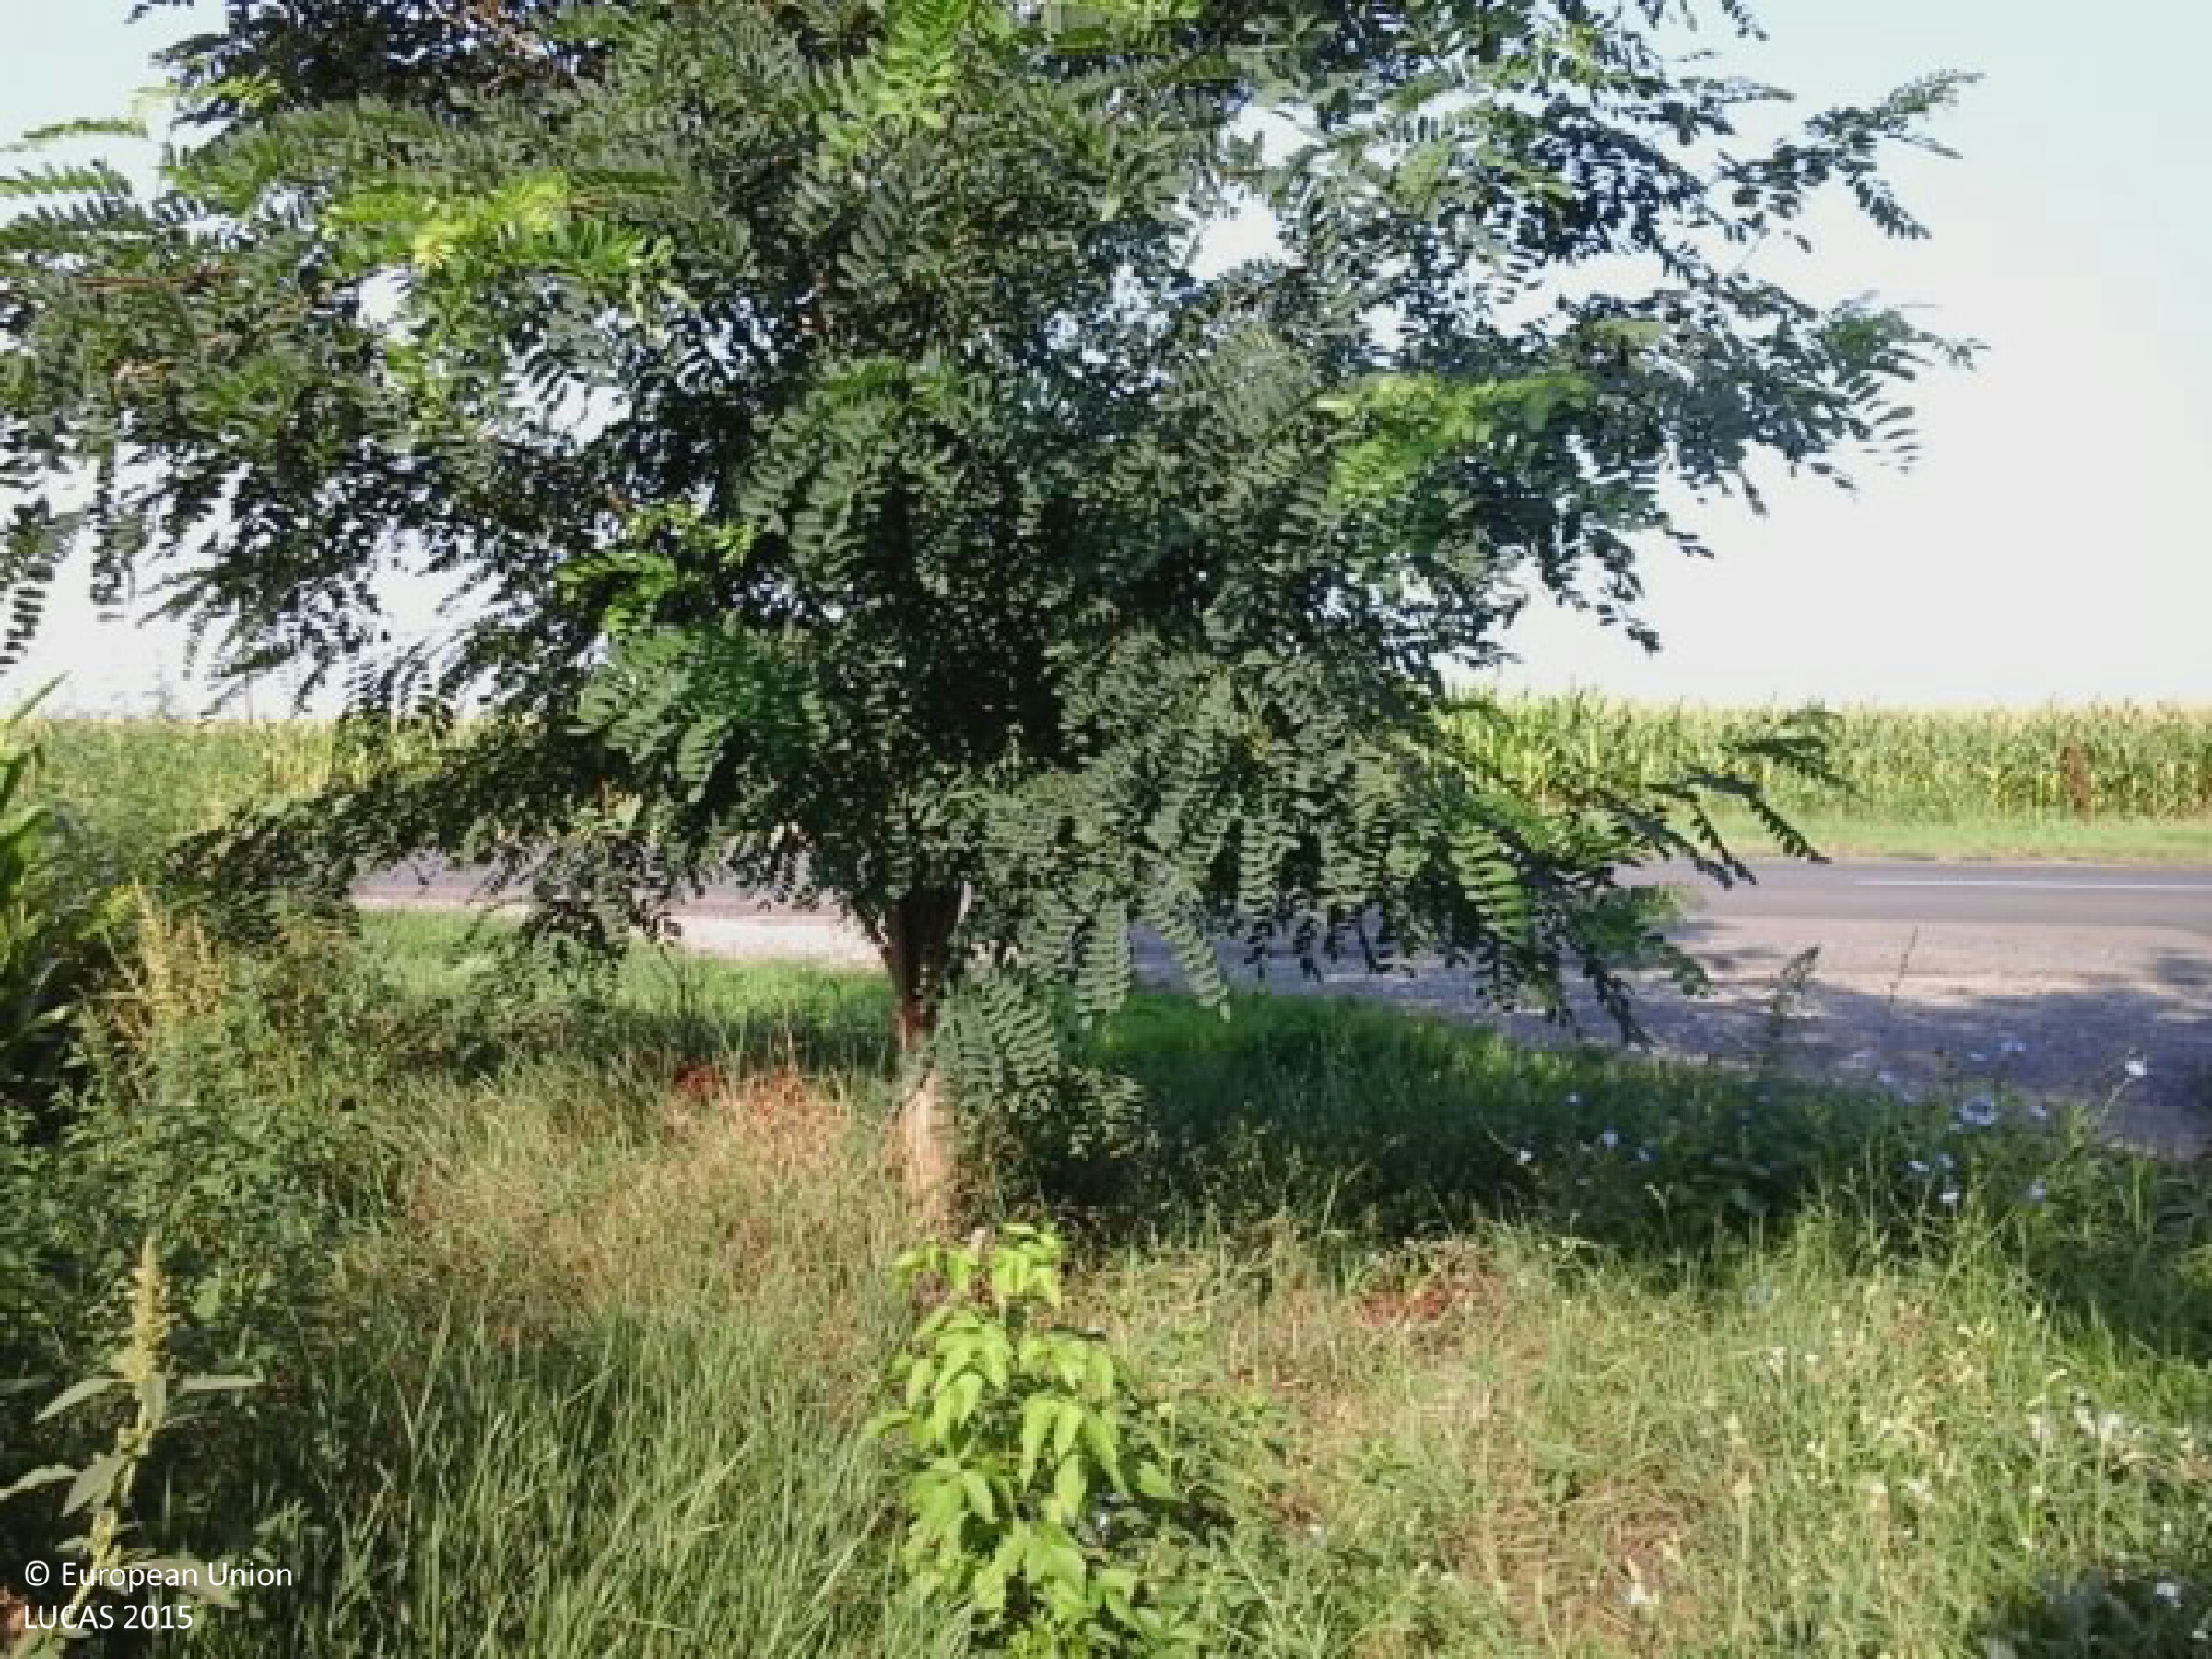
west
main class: Cropland
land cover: Maize
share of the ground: > 75 %
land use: Agriculture (excluding fallow land and kitchen gardens)
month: August
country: HU
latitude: 46.4918
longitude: 17.9151
